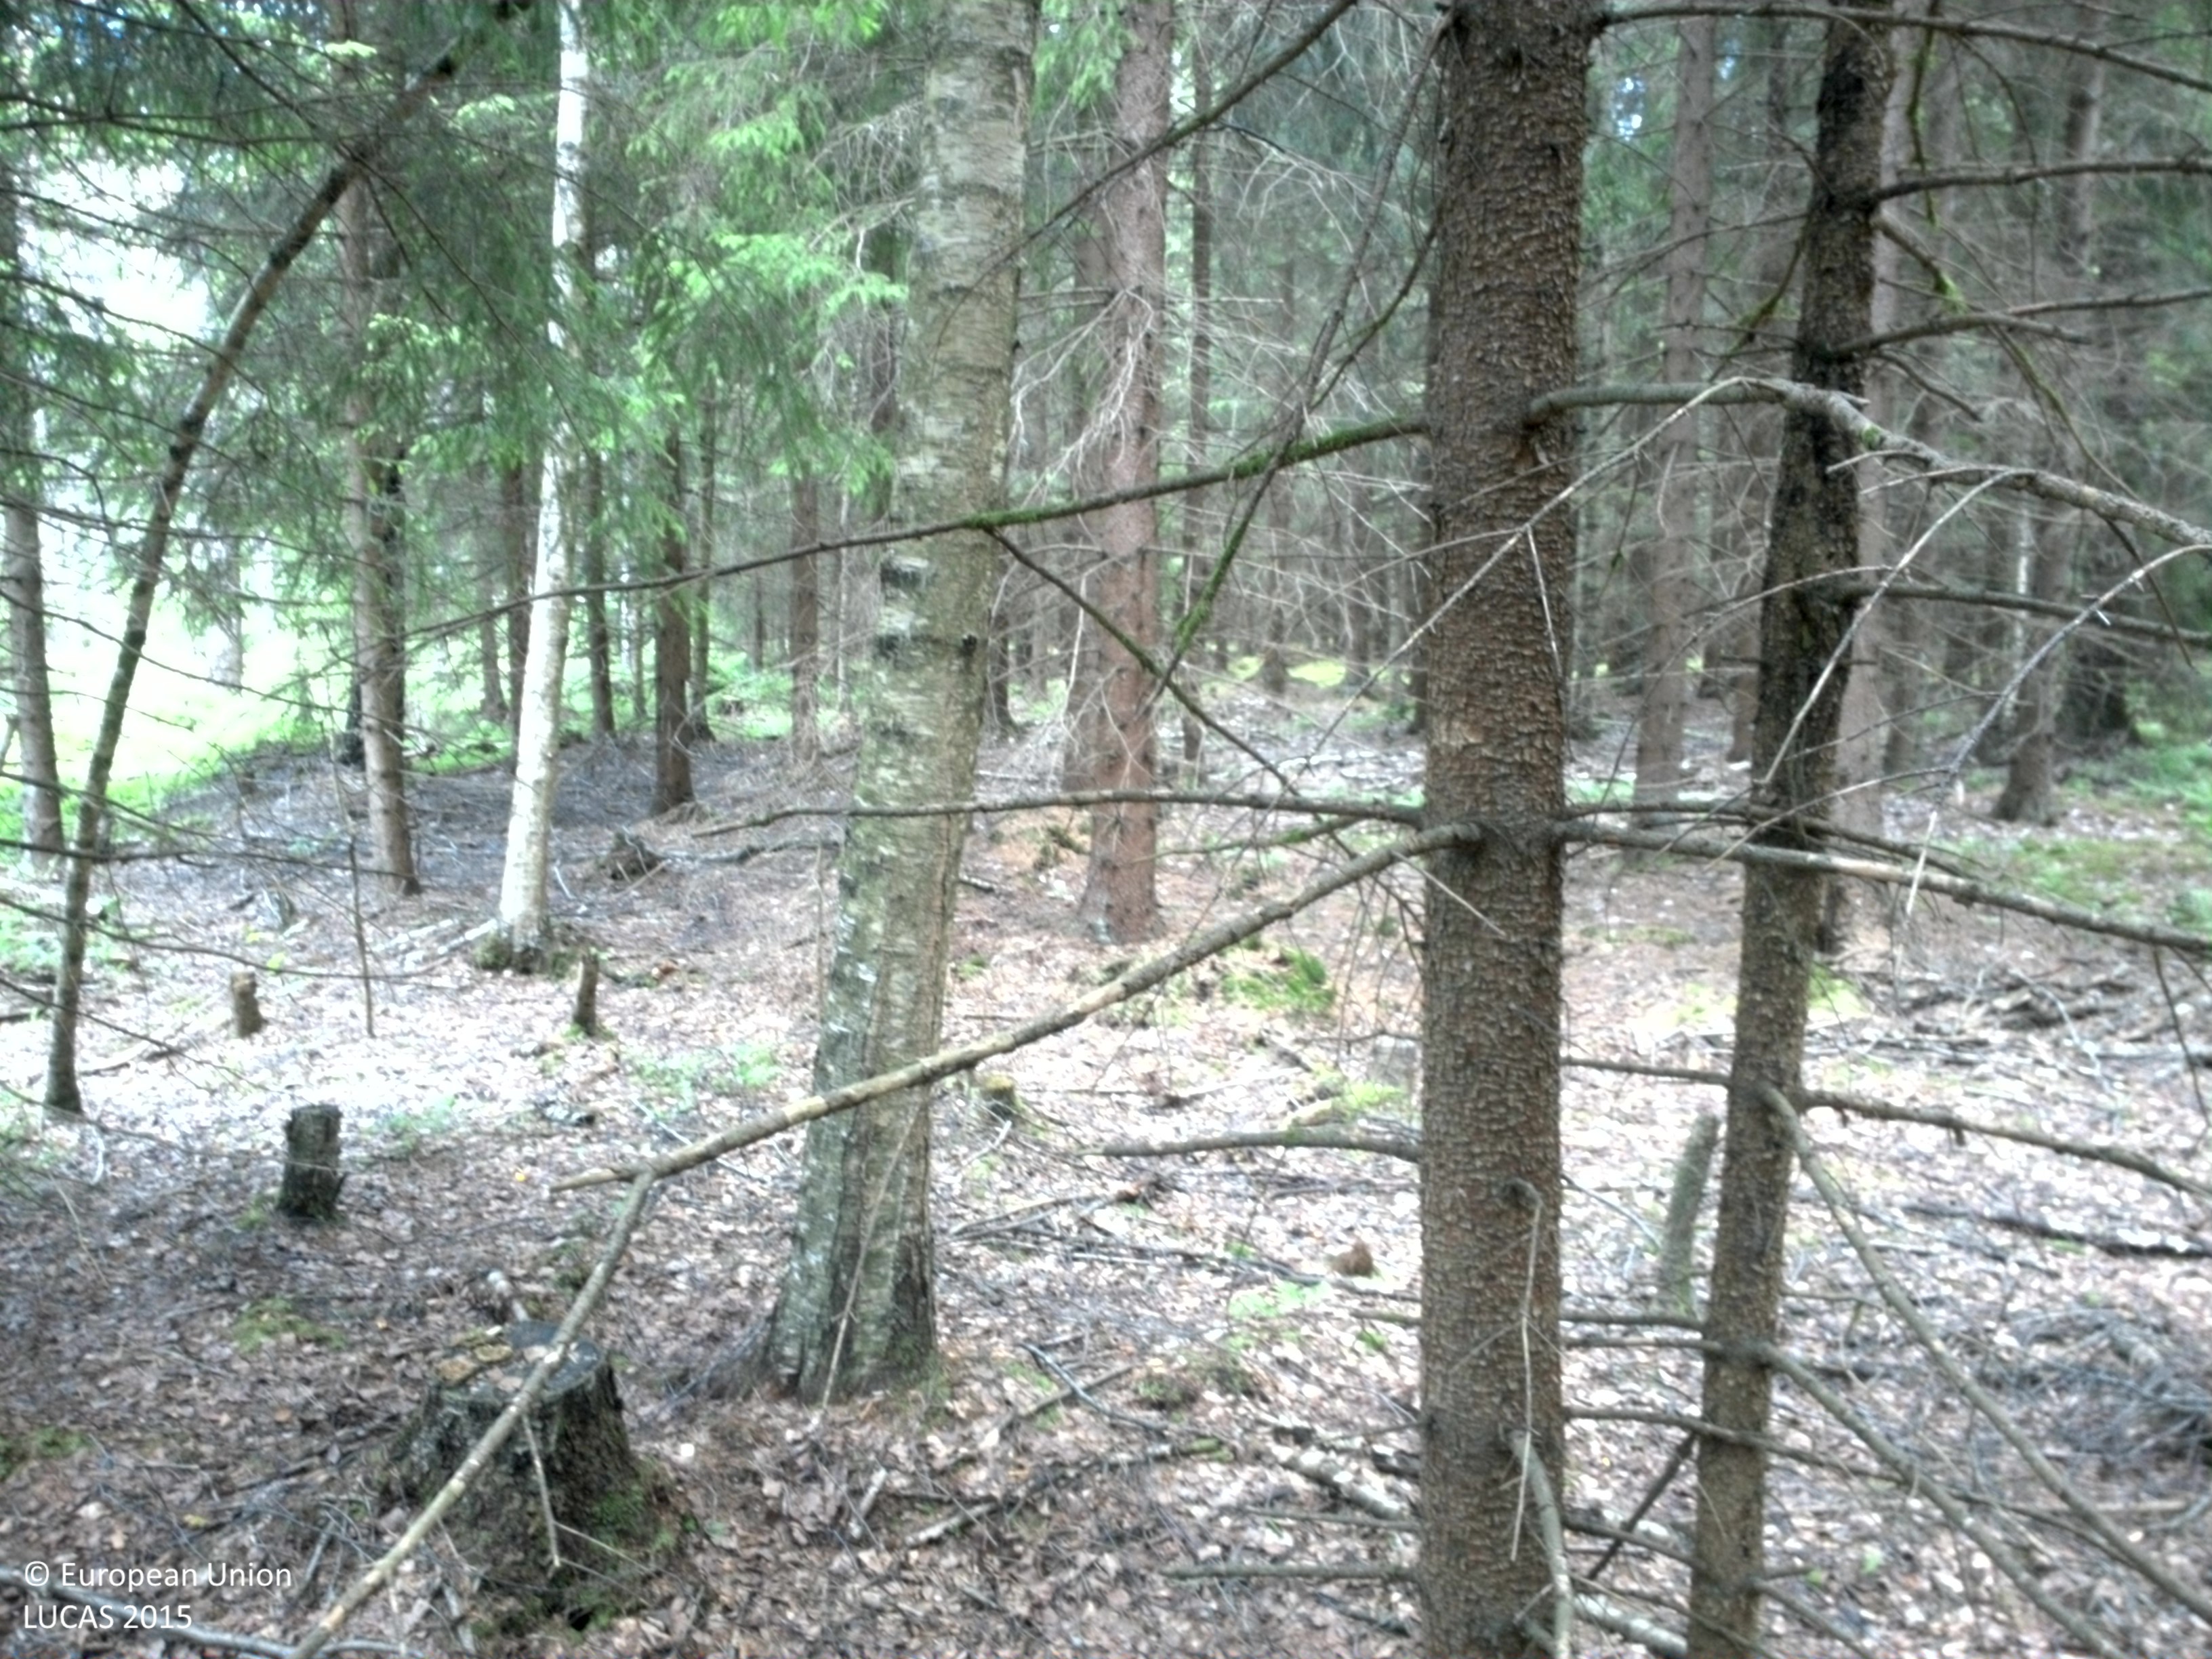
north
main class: Woodland
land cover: Spruce dominated coniferous woodland
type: boreal forest
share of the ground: 50 - 75 %
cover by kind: coniferous forest trees 70 %, herbaceous plants 10 %, consolidated bare surface 10 %, broadleaved forest trees 5 %, lichens and mosses 5 %
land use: Forestry
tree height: > 5 m
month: June
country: SE
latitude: 58.5629
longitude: 15.3743
